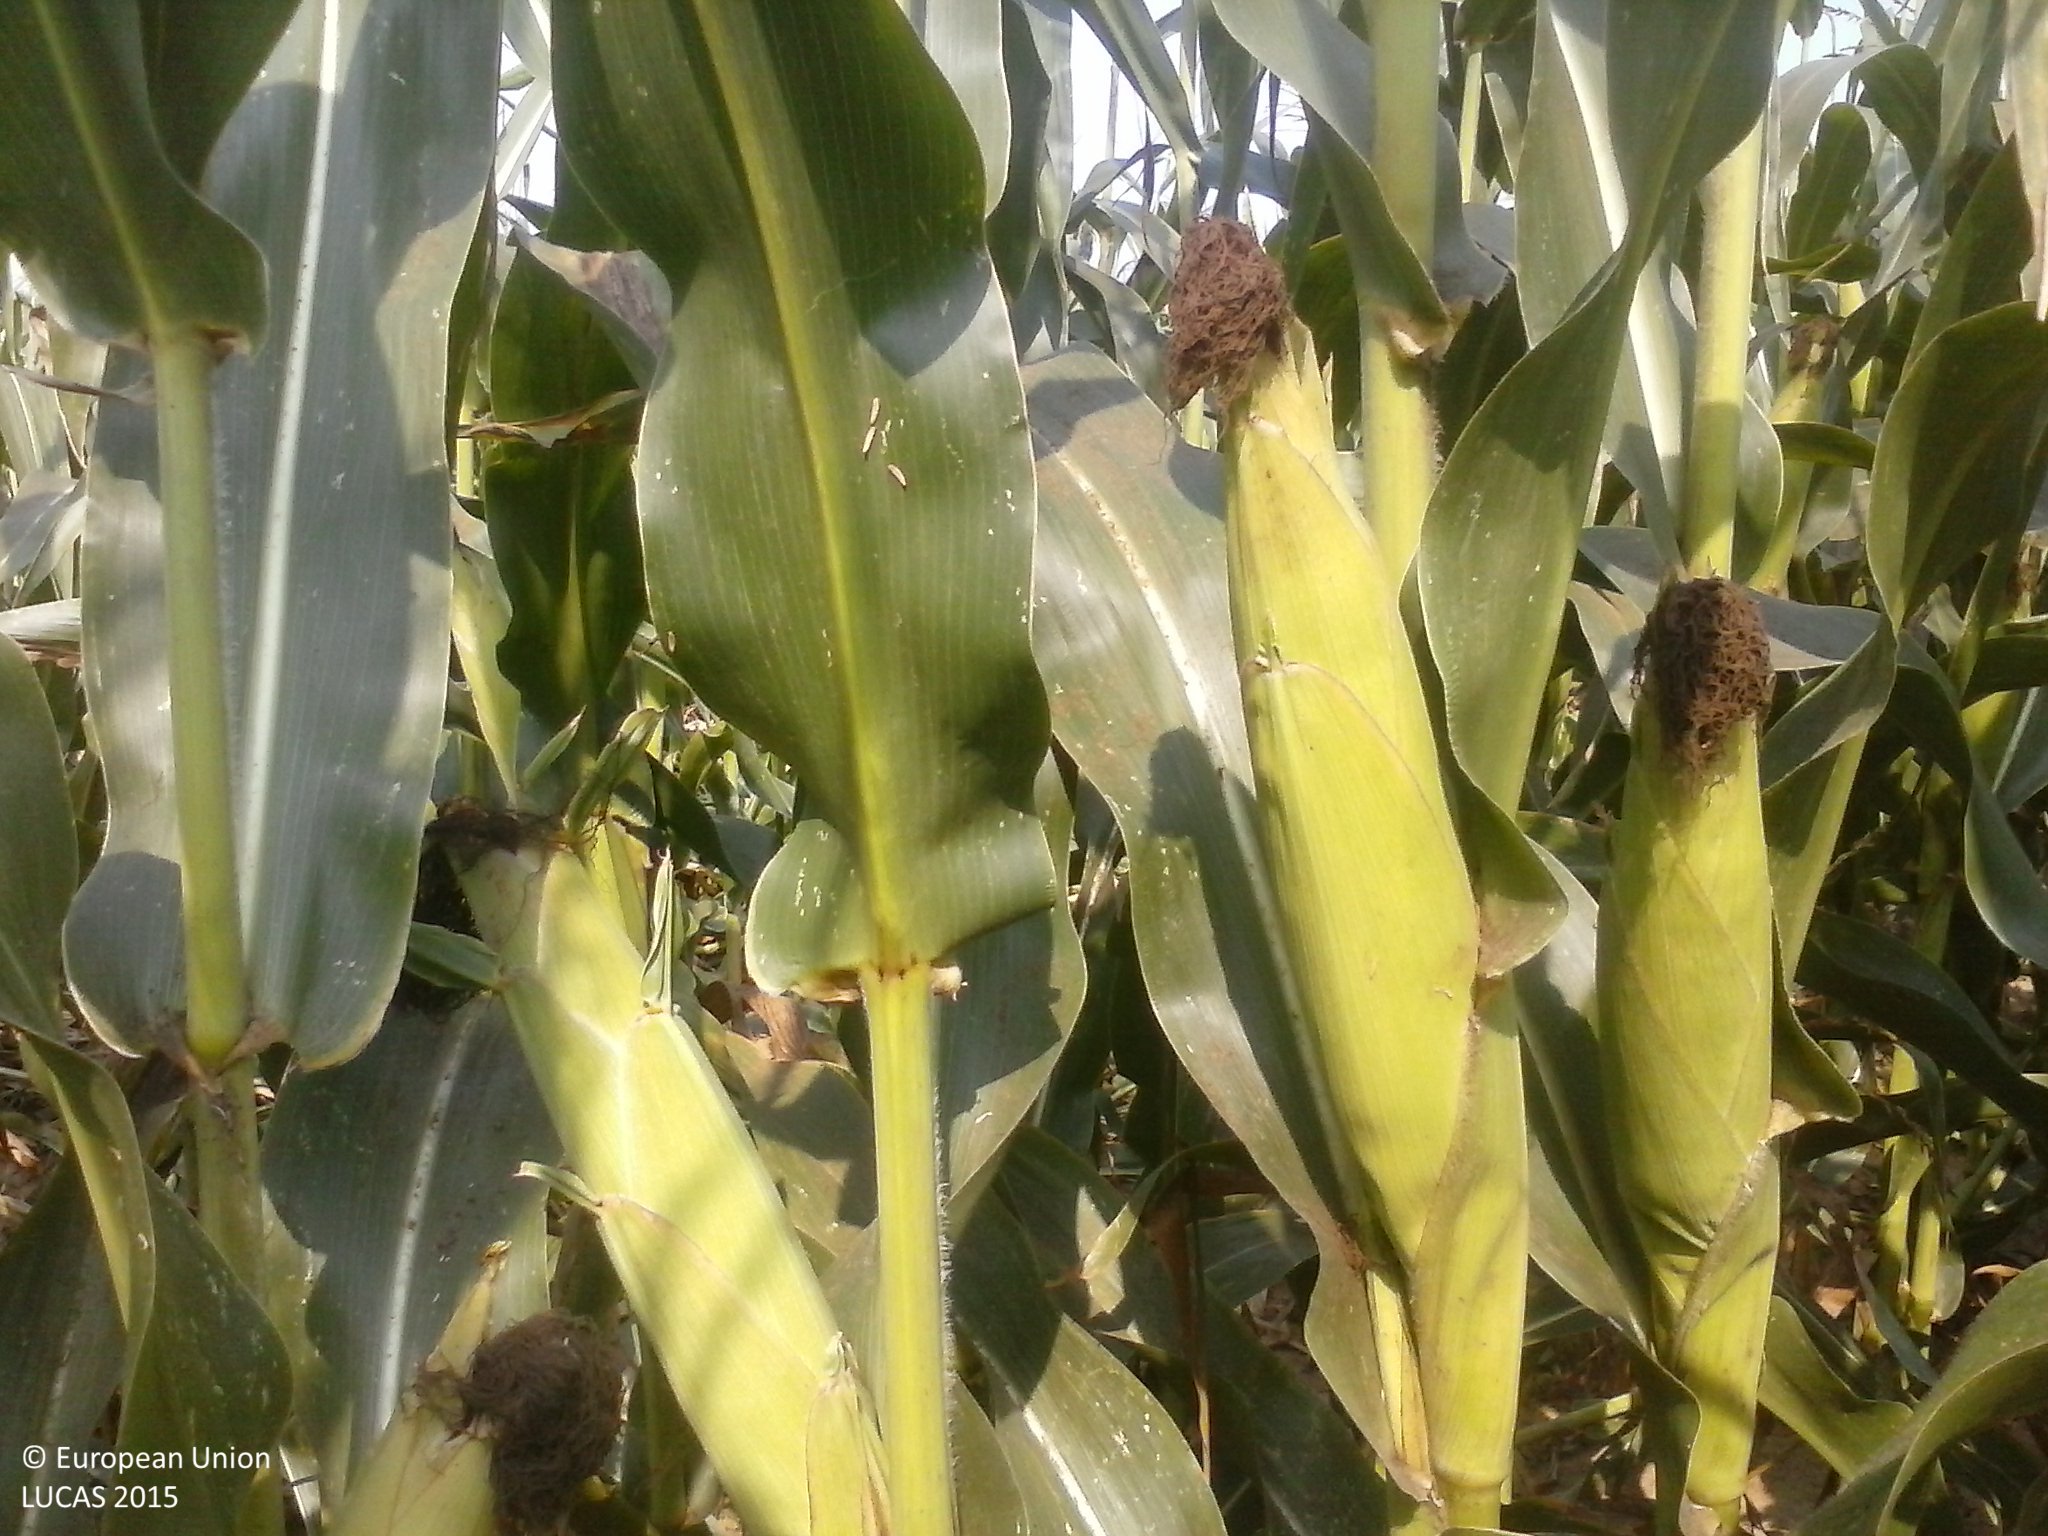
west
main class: Cropland
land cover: Maize
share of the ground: > 75 %
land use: Agriculture (excluding fallow land and kitchen gardens)
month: August
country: HU
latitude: 46.1895
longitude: 17.8443
